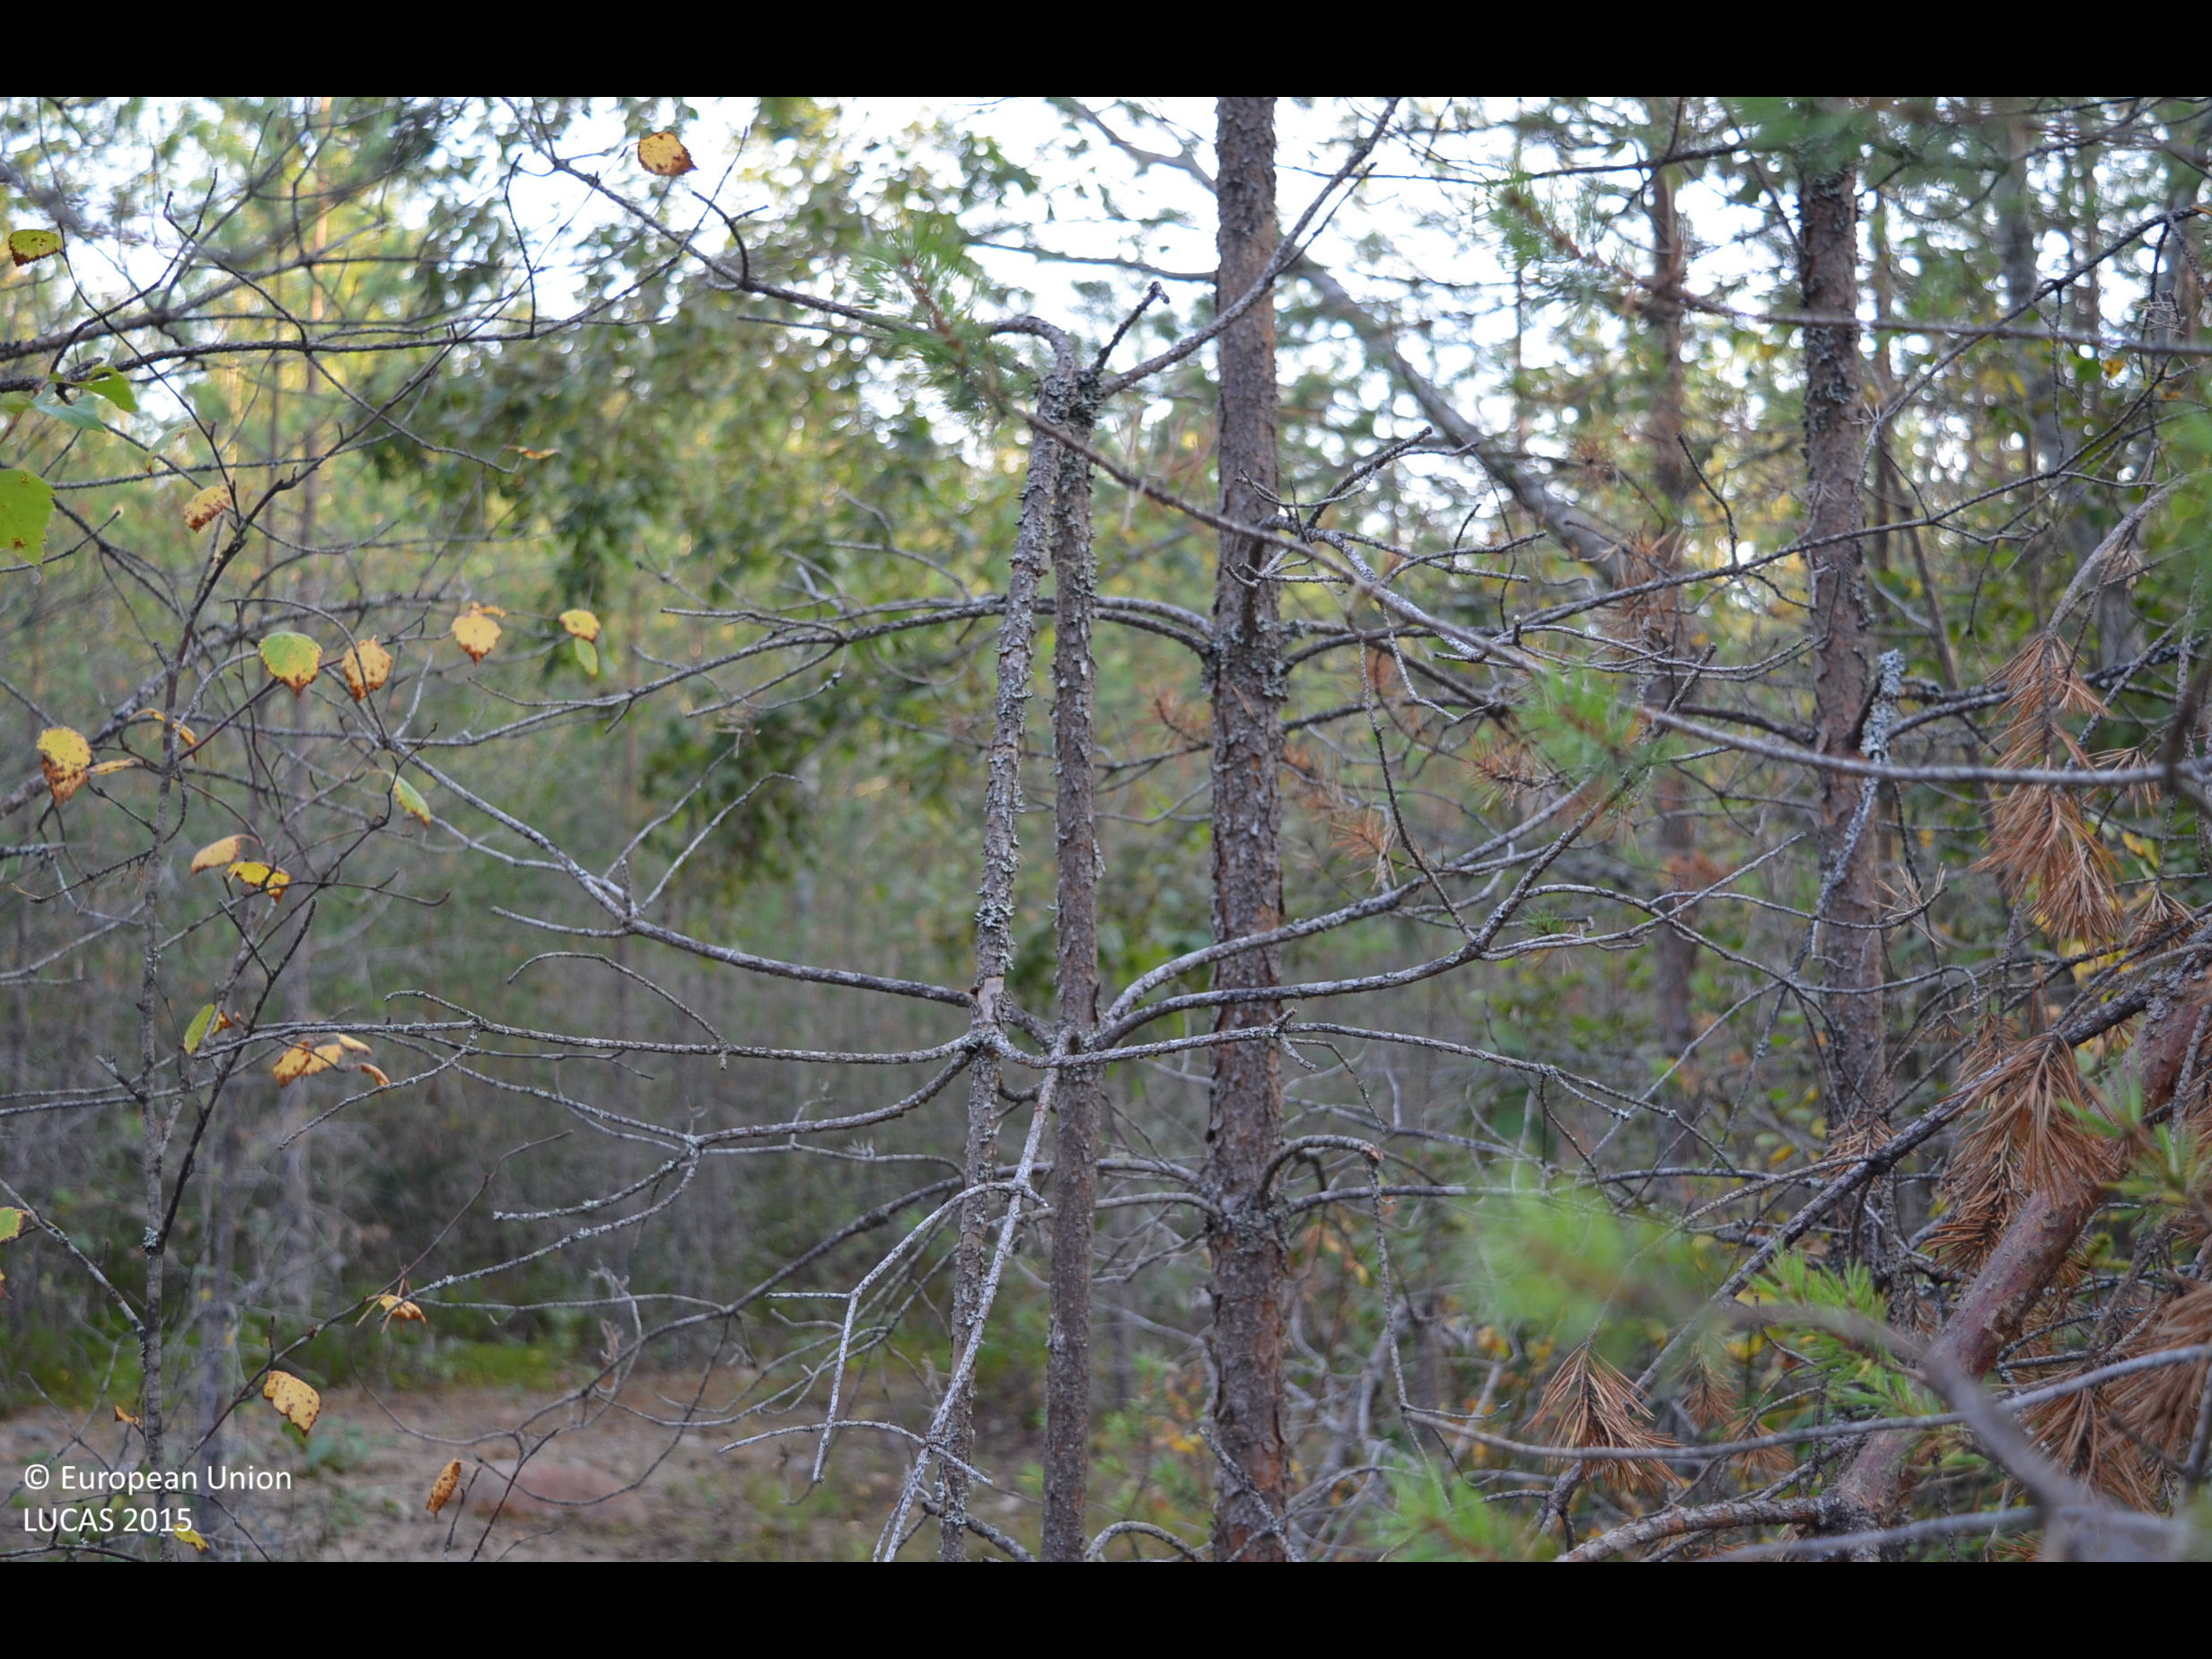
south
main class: Woodland
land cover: Pine dominated coniferous woodland
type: boreal forest
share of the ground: 50 - 75 %
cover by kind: coniferous forest trees 50 %, broadleaved forest trees 15 %, lichens and mosses 10 %, consolidated bare surface 10 %, shrubs 5 %
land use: Forestry
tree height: > 5 m
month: September
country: FI
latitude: 63.0440
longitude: 23.7336
